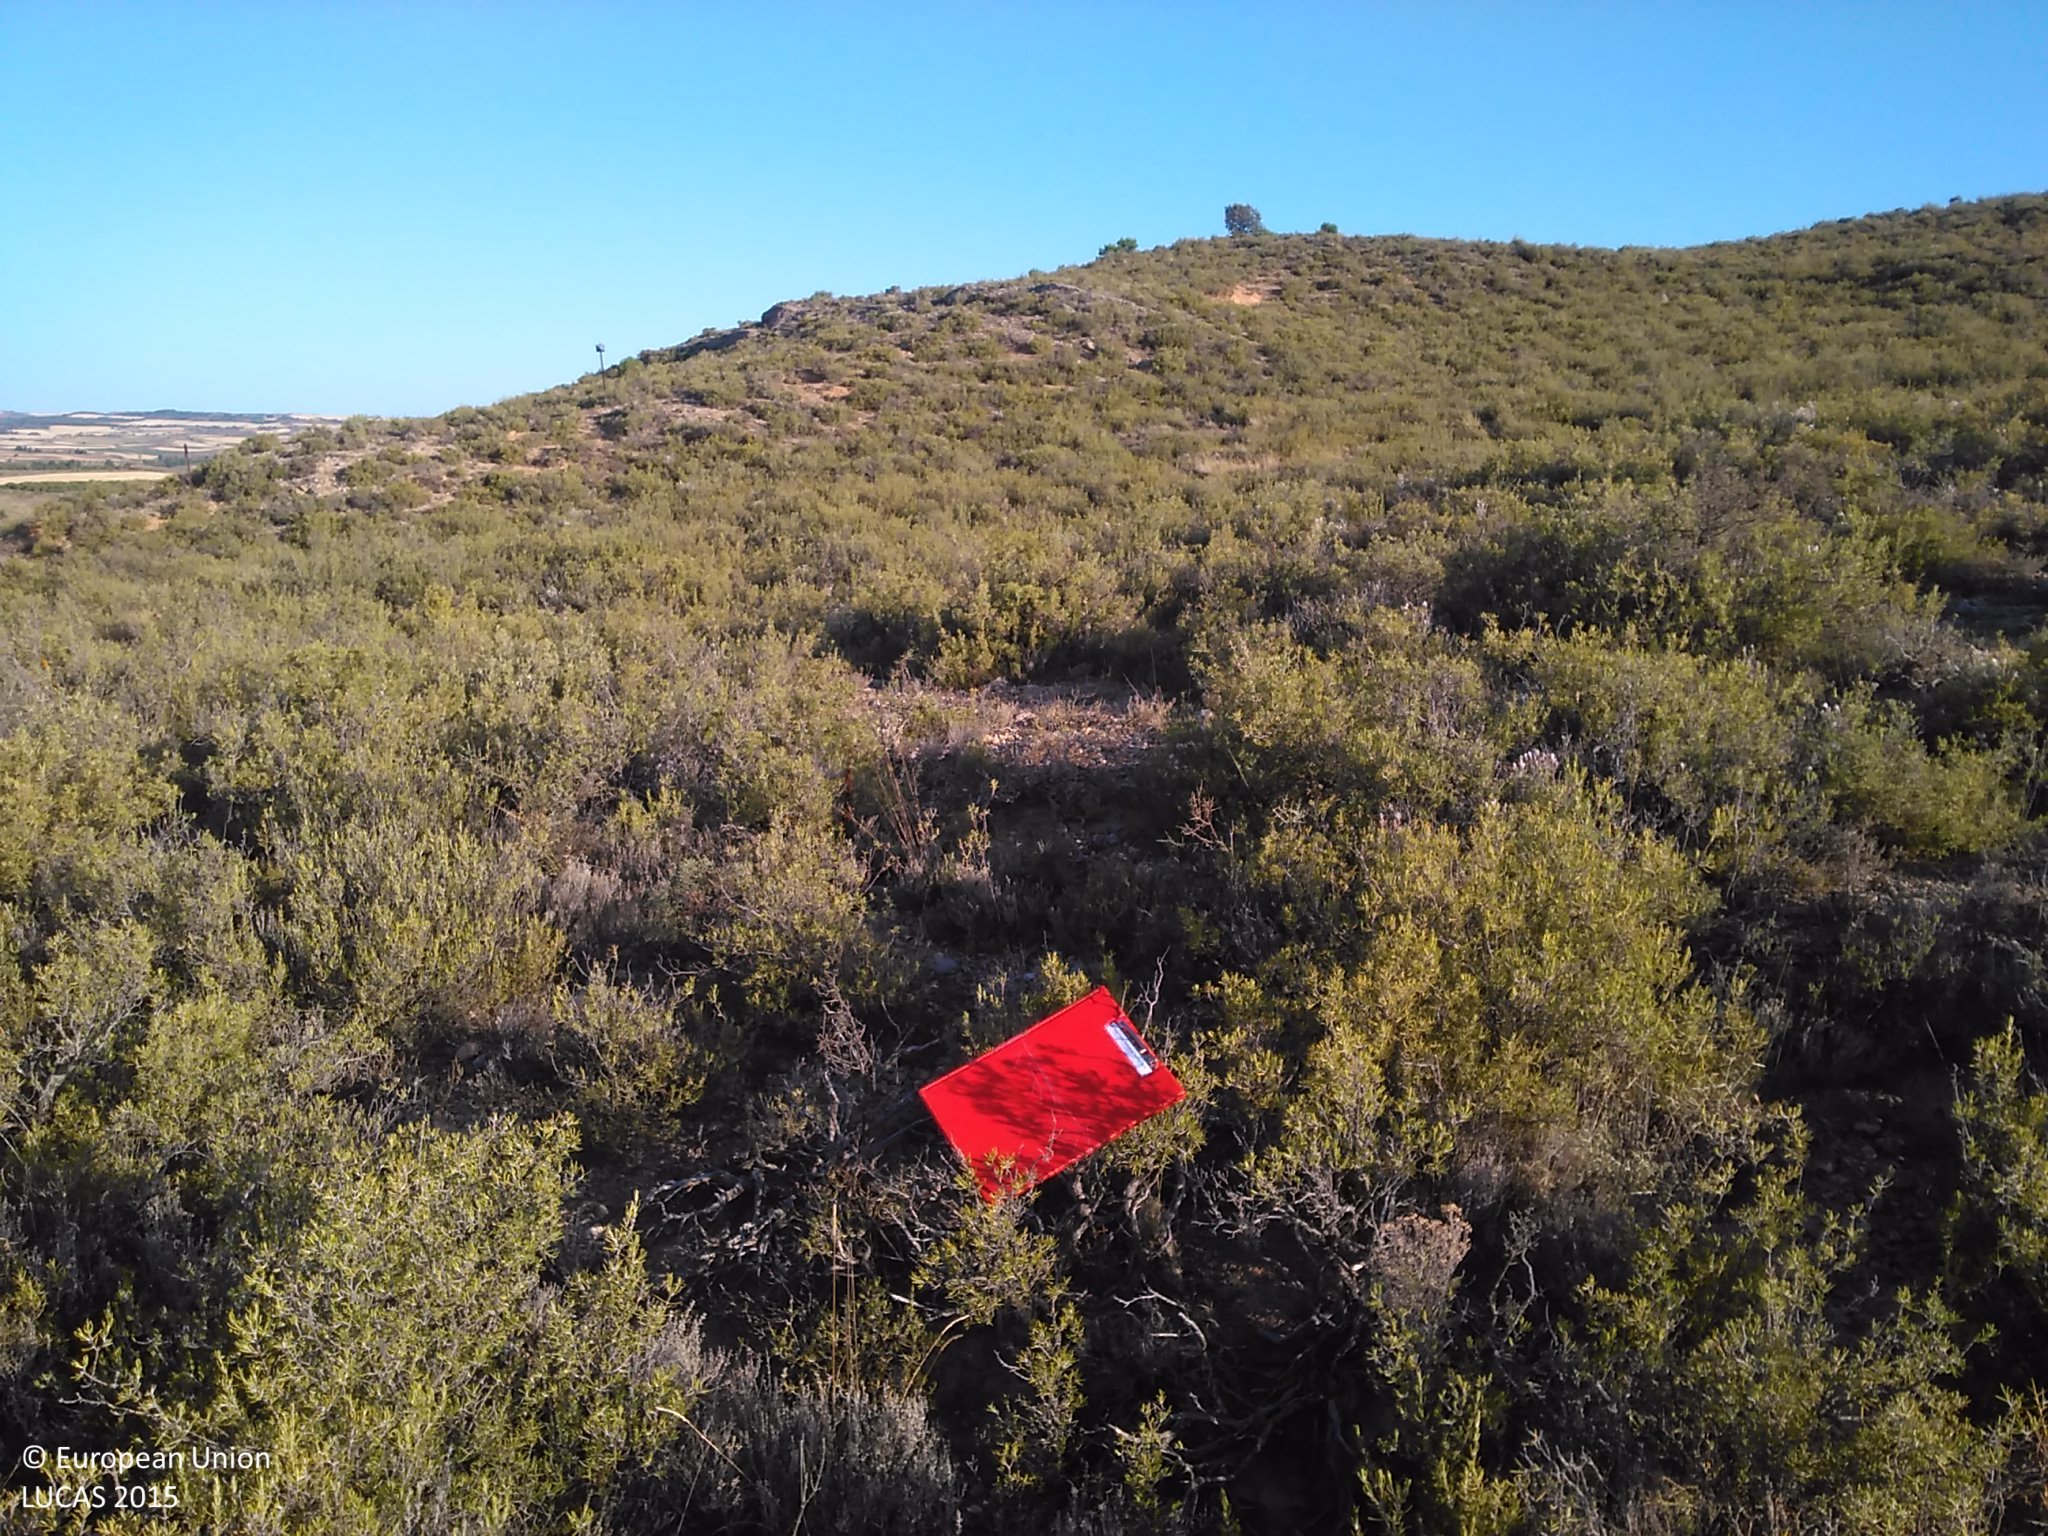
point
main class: Shrubland
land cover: Shrubland without tree cover
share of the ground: 50 - 75 %
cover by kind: shrubs 60 %, unconsolidated bare surface 35 %, herbaceous plants 5 %
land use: Semi-natural and natural areas not in use
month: July
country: ES
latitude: 41.4801
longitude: -2.1632
